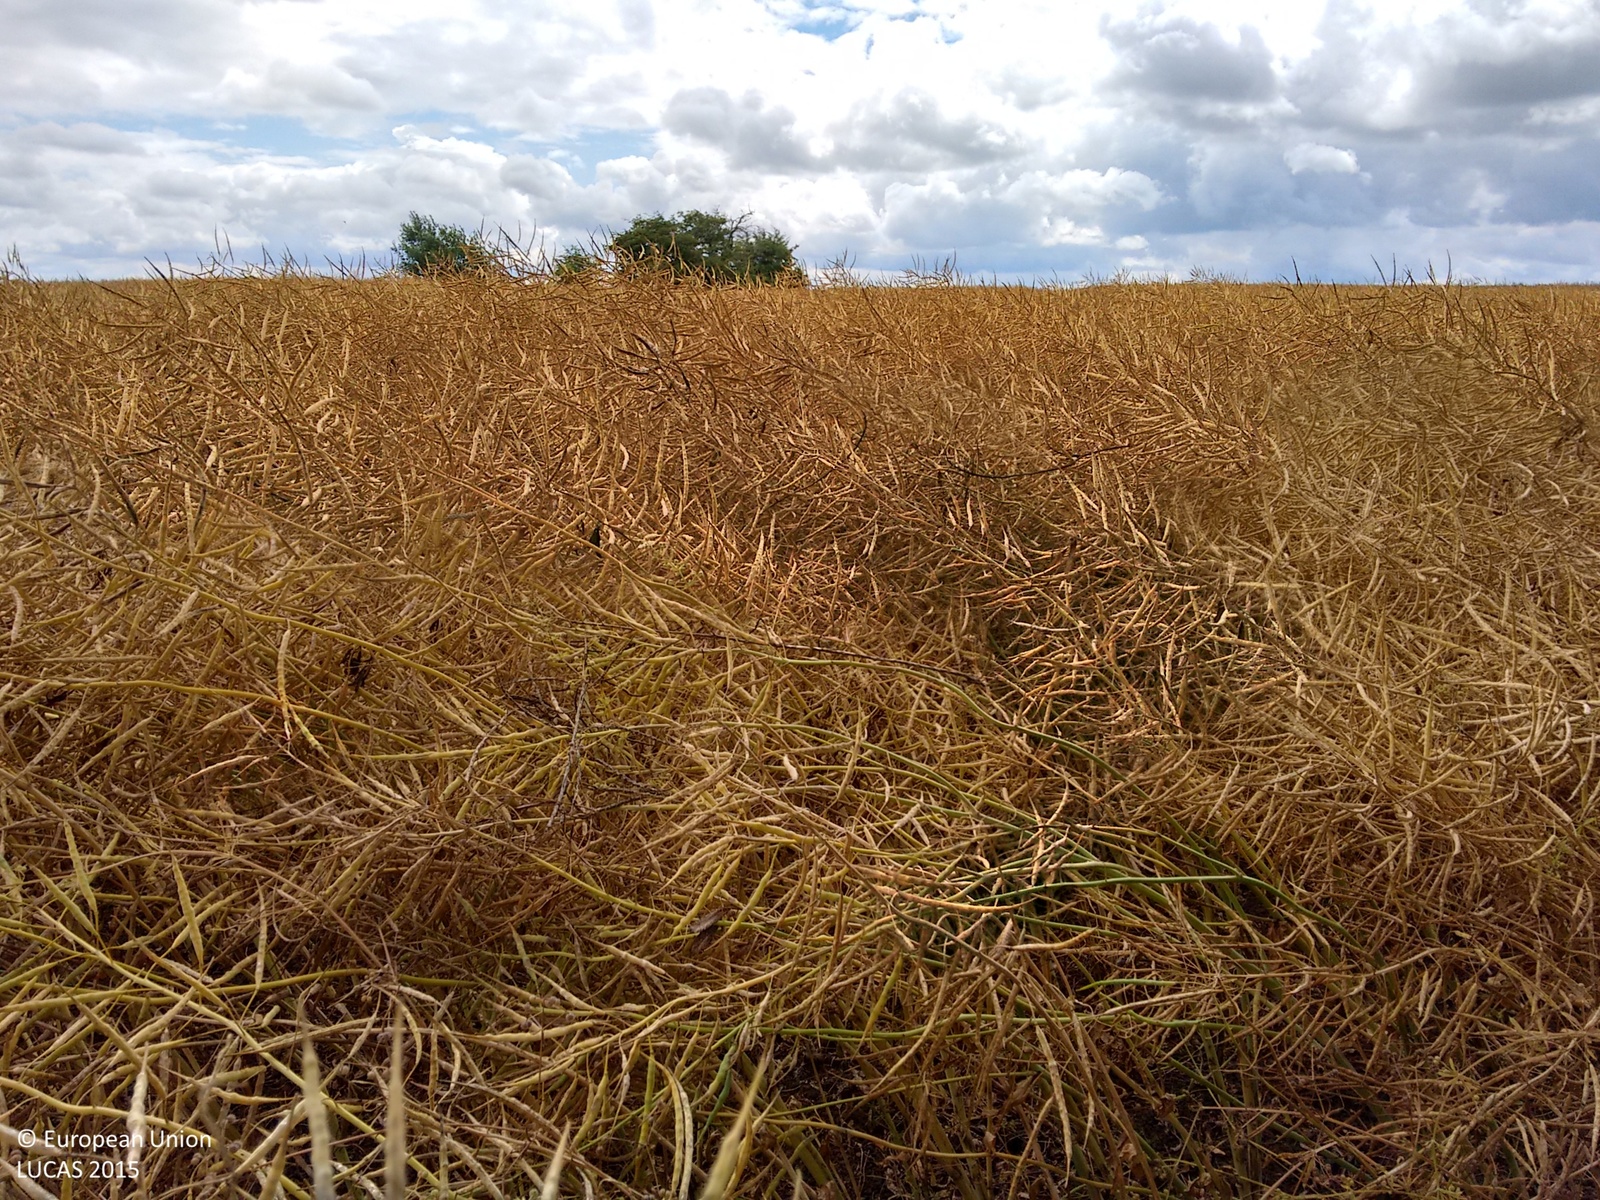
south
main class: Cropland
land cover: Rape and turnip rape
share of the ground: > 75 %
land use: Agriculture (excluding fallow land and kitchen gardens)
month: July
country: GB
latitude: 52.7378
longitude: -0.7792
